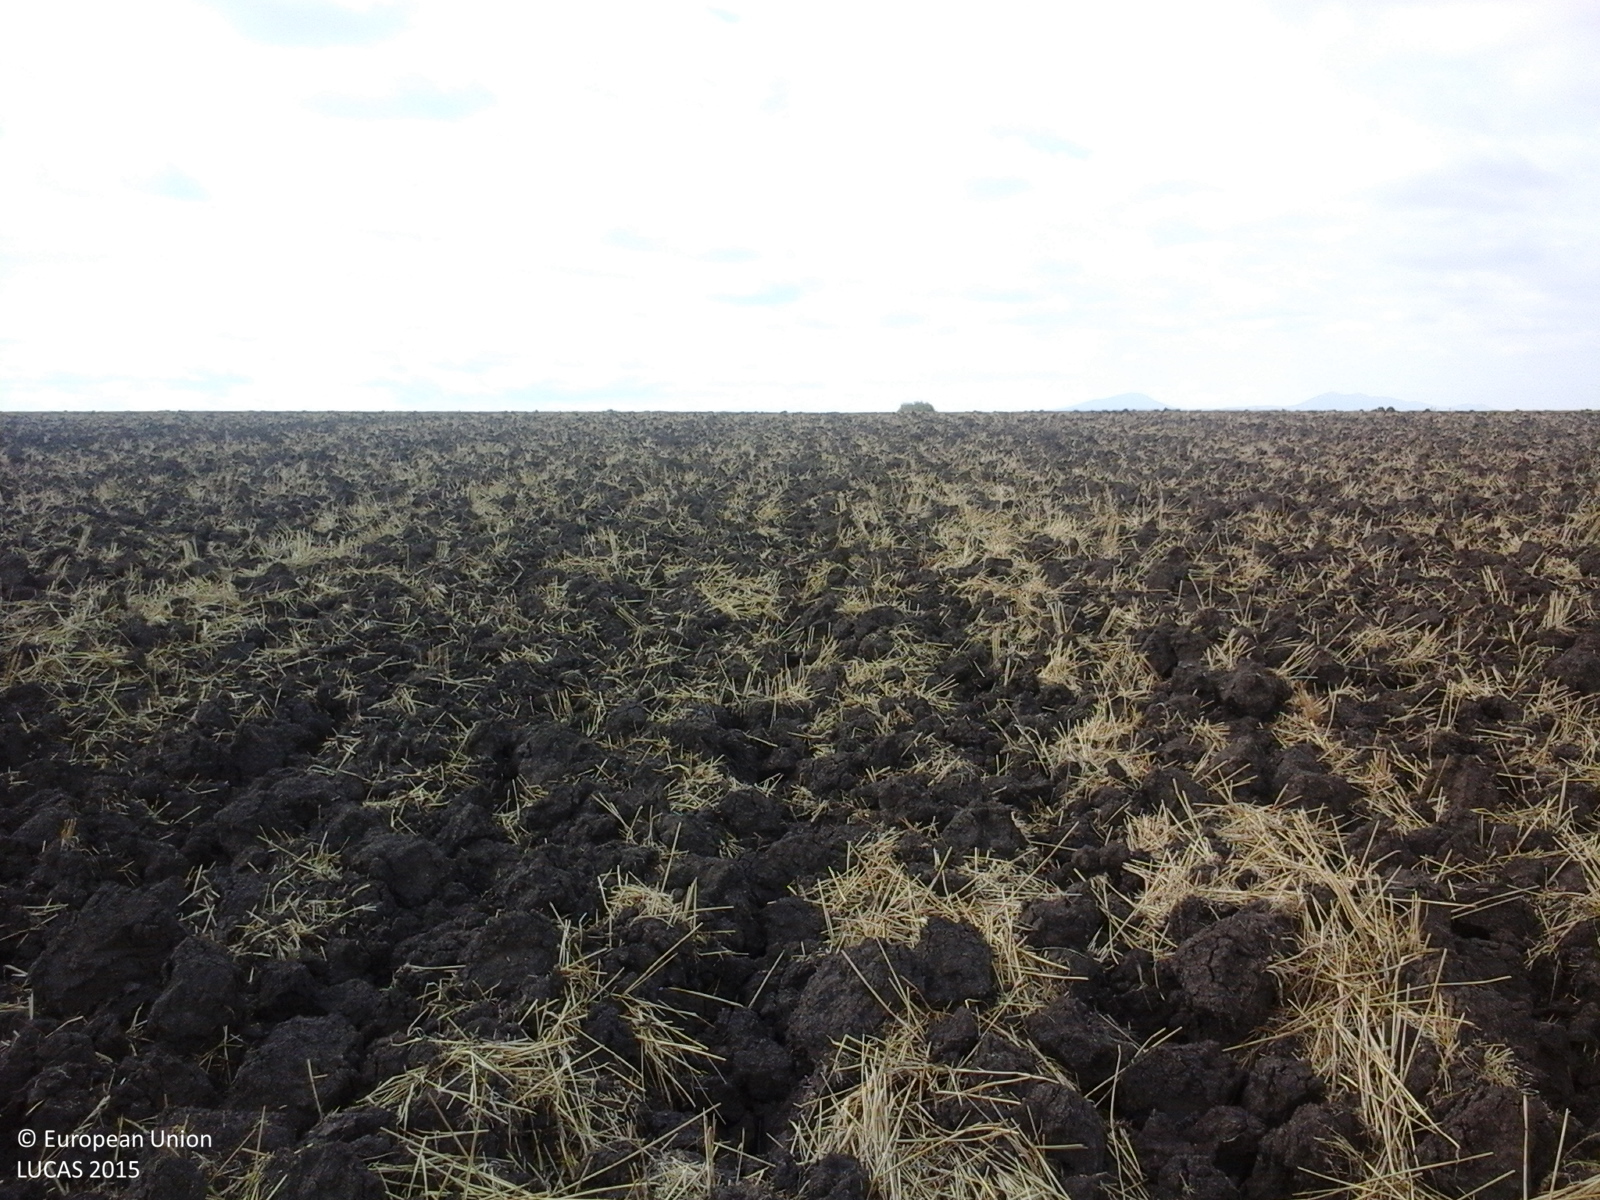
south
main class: Cropland
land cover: Common wheat
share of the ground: < 10 %
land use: Agriculture (excluding fallow land and kitchen gardens)
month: August
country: RO
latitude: 45.3640
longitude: 21.5090
